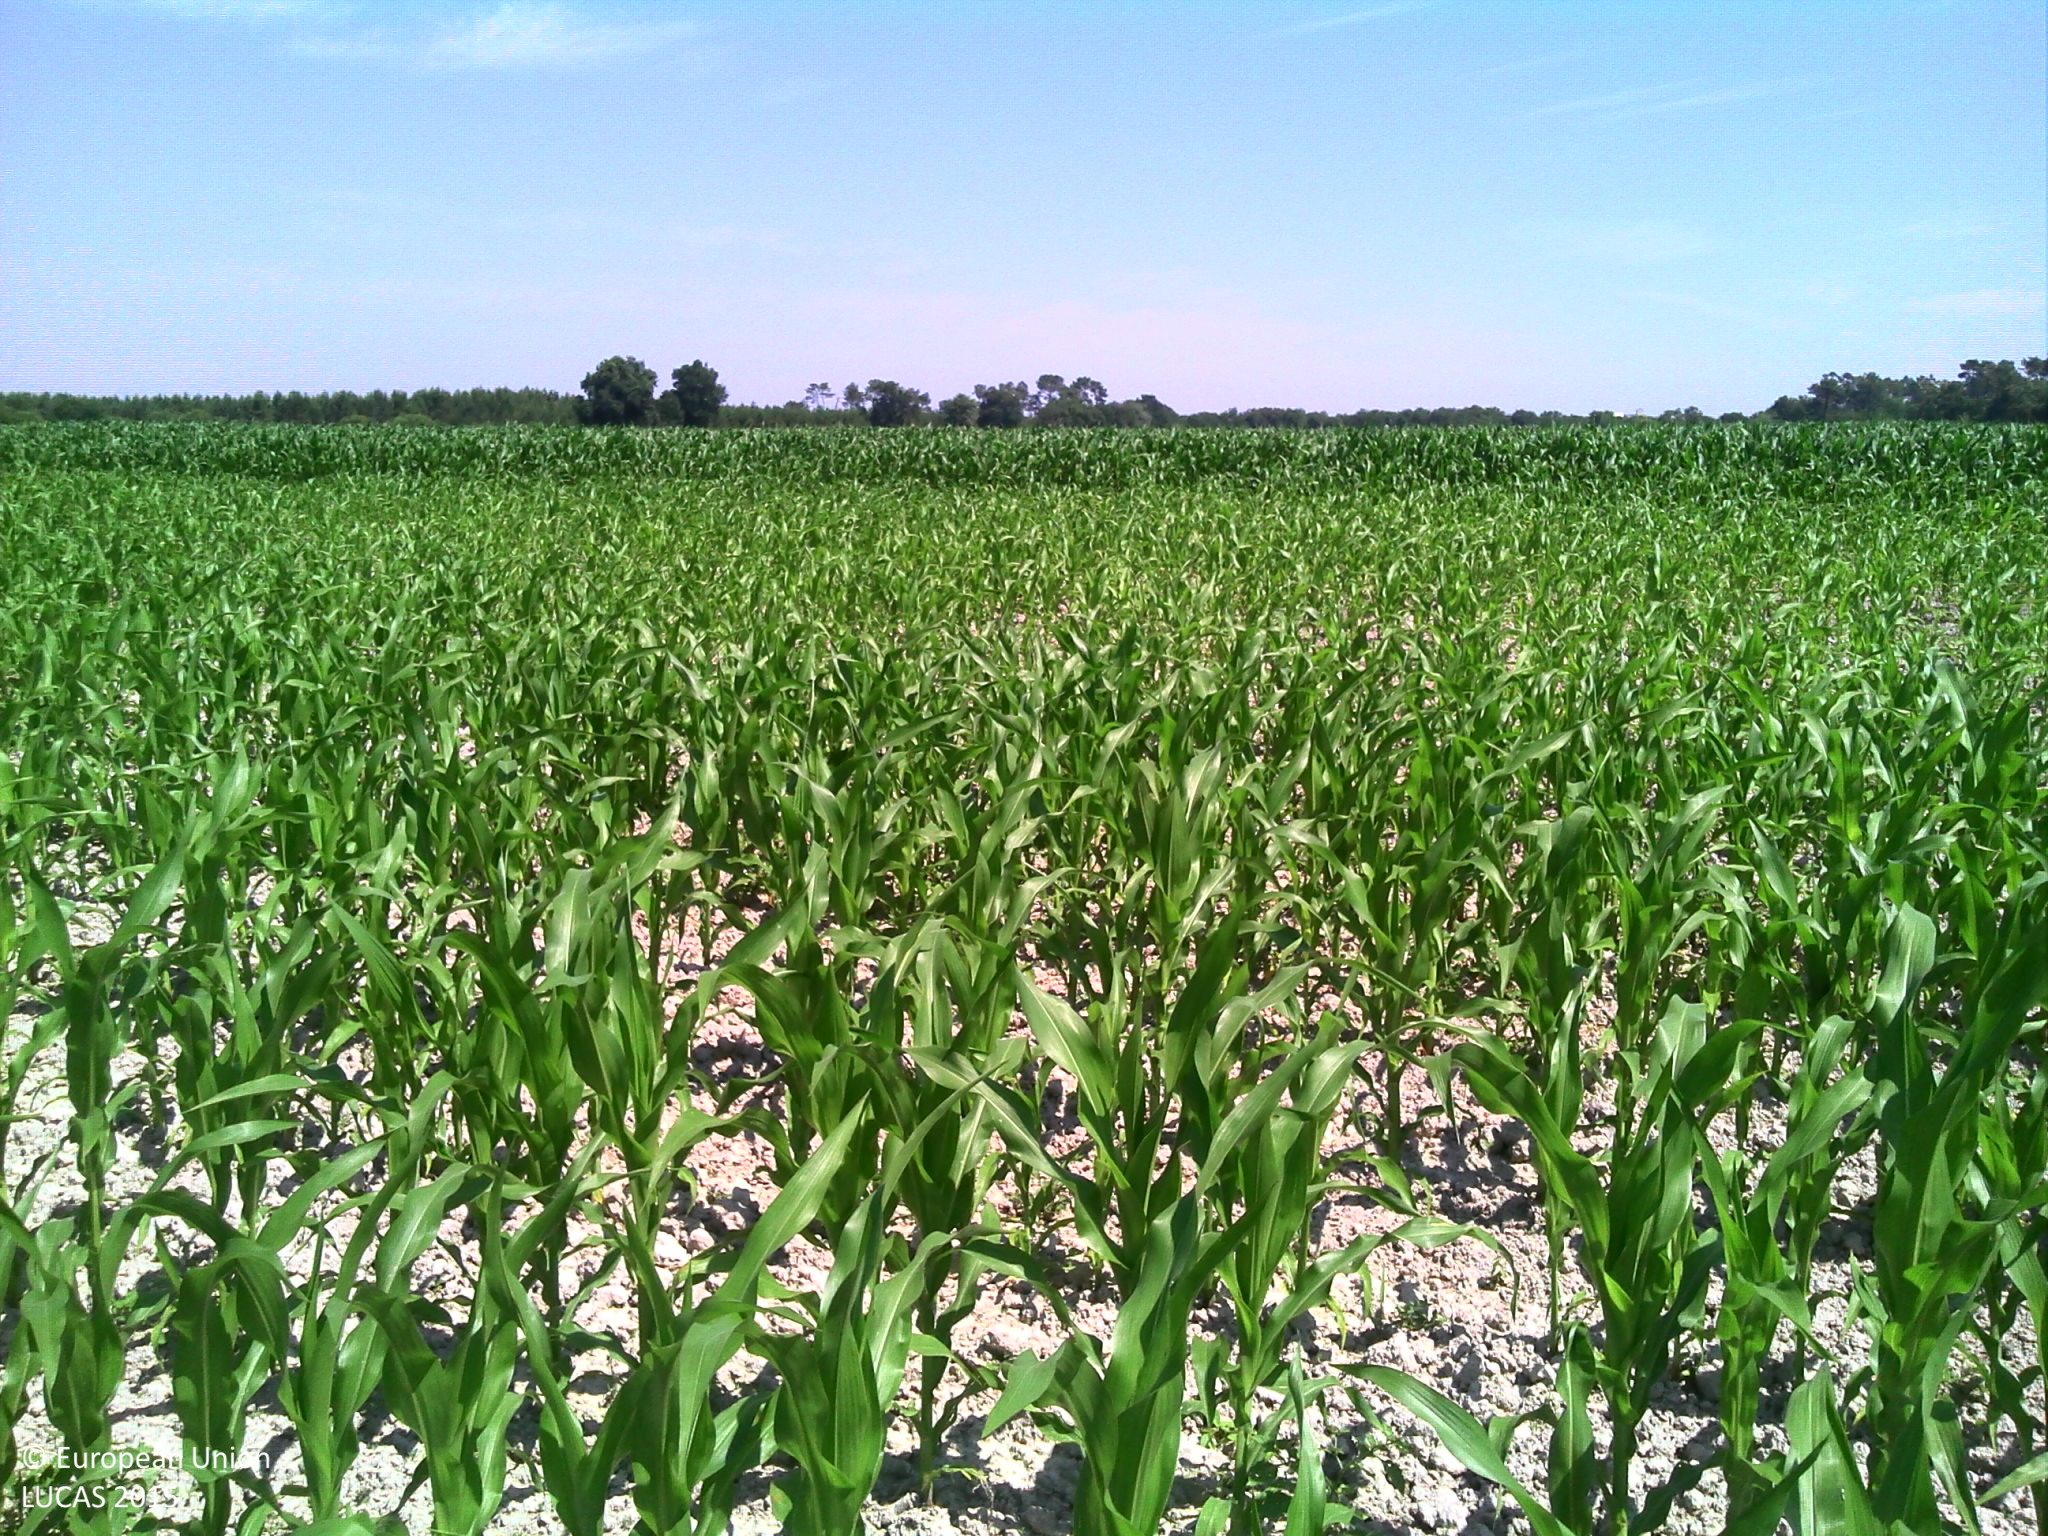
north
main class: Cropland
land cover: Maize
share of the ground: 50 - 75 %
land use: Agriculture (excluding fallow land and kitchen gardens)
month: June
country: FR
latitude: 43.6312
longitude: -0.5332
